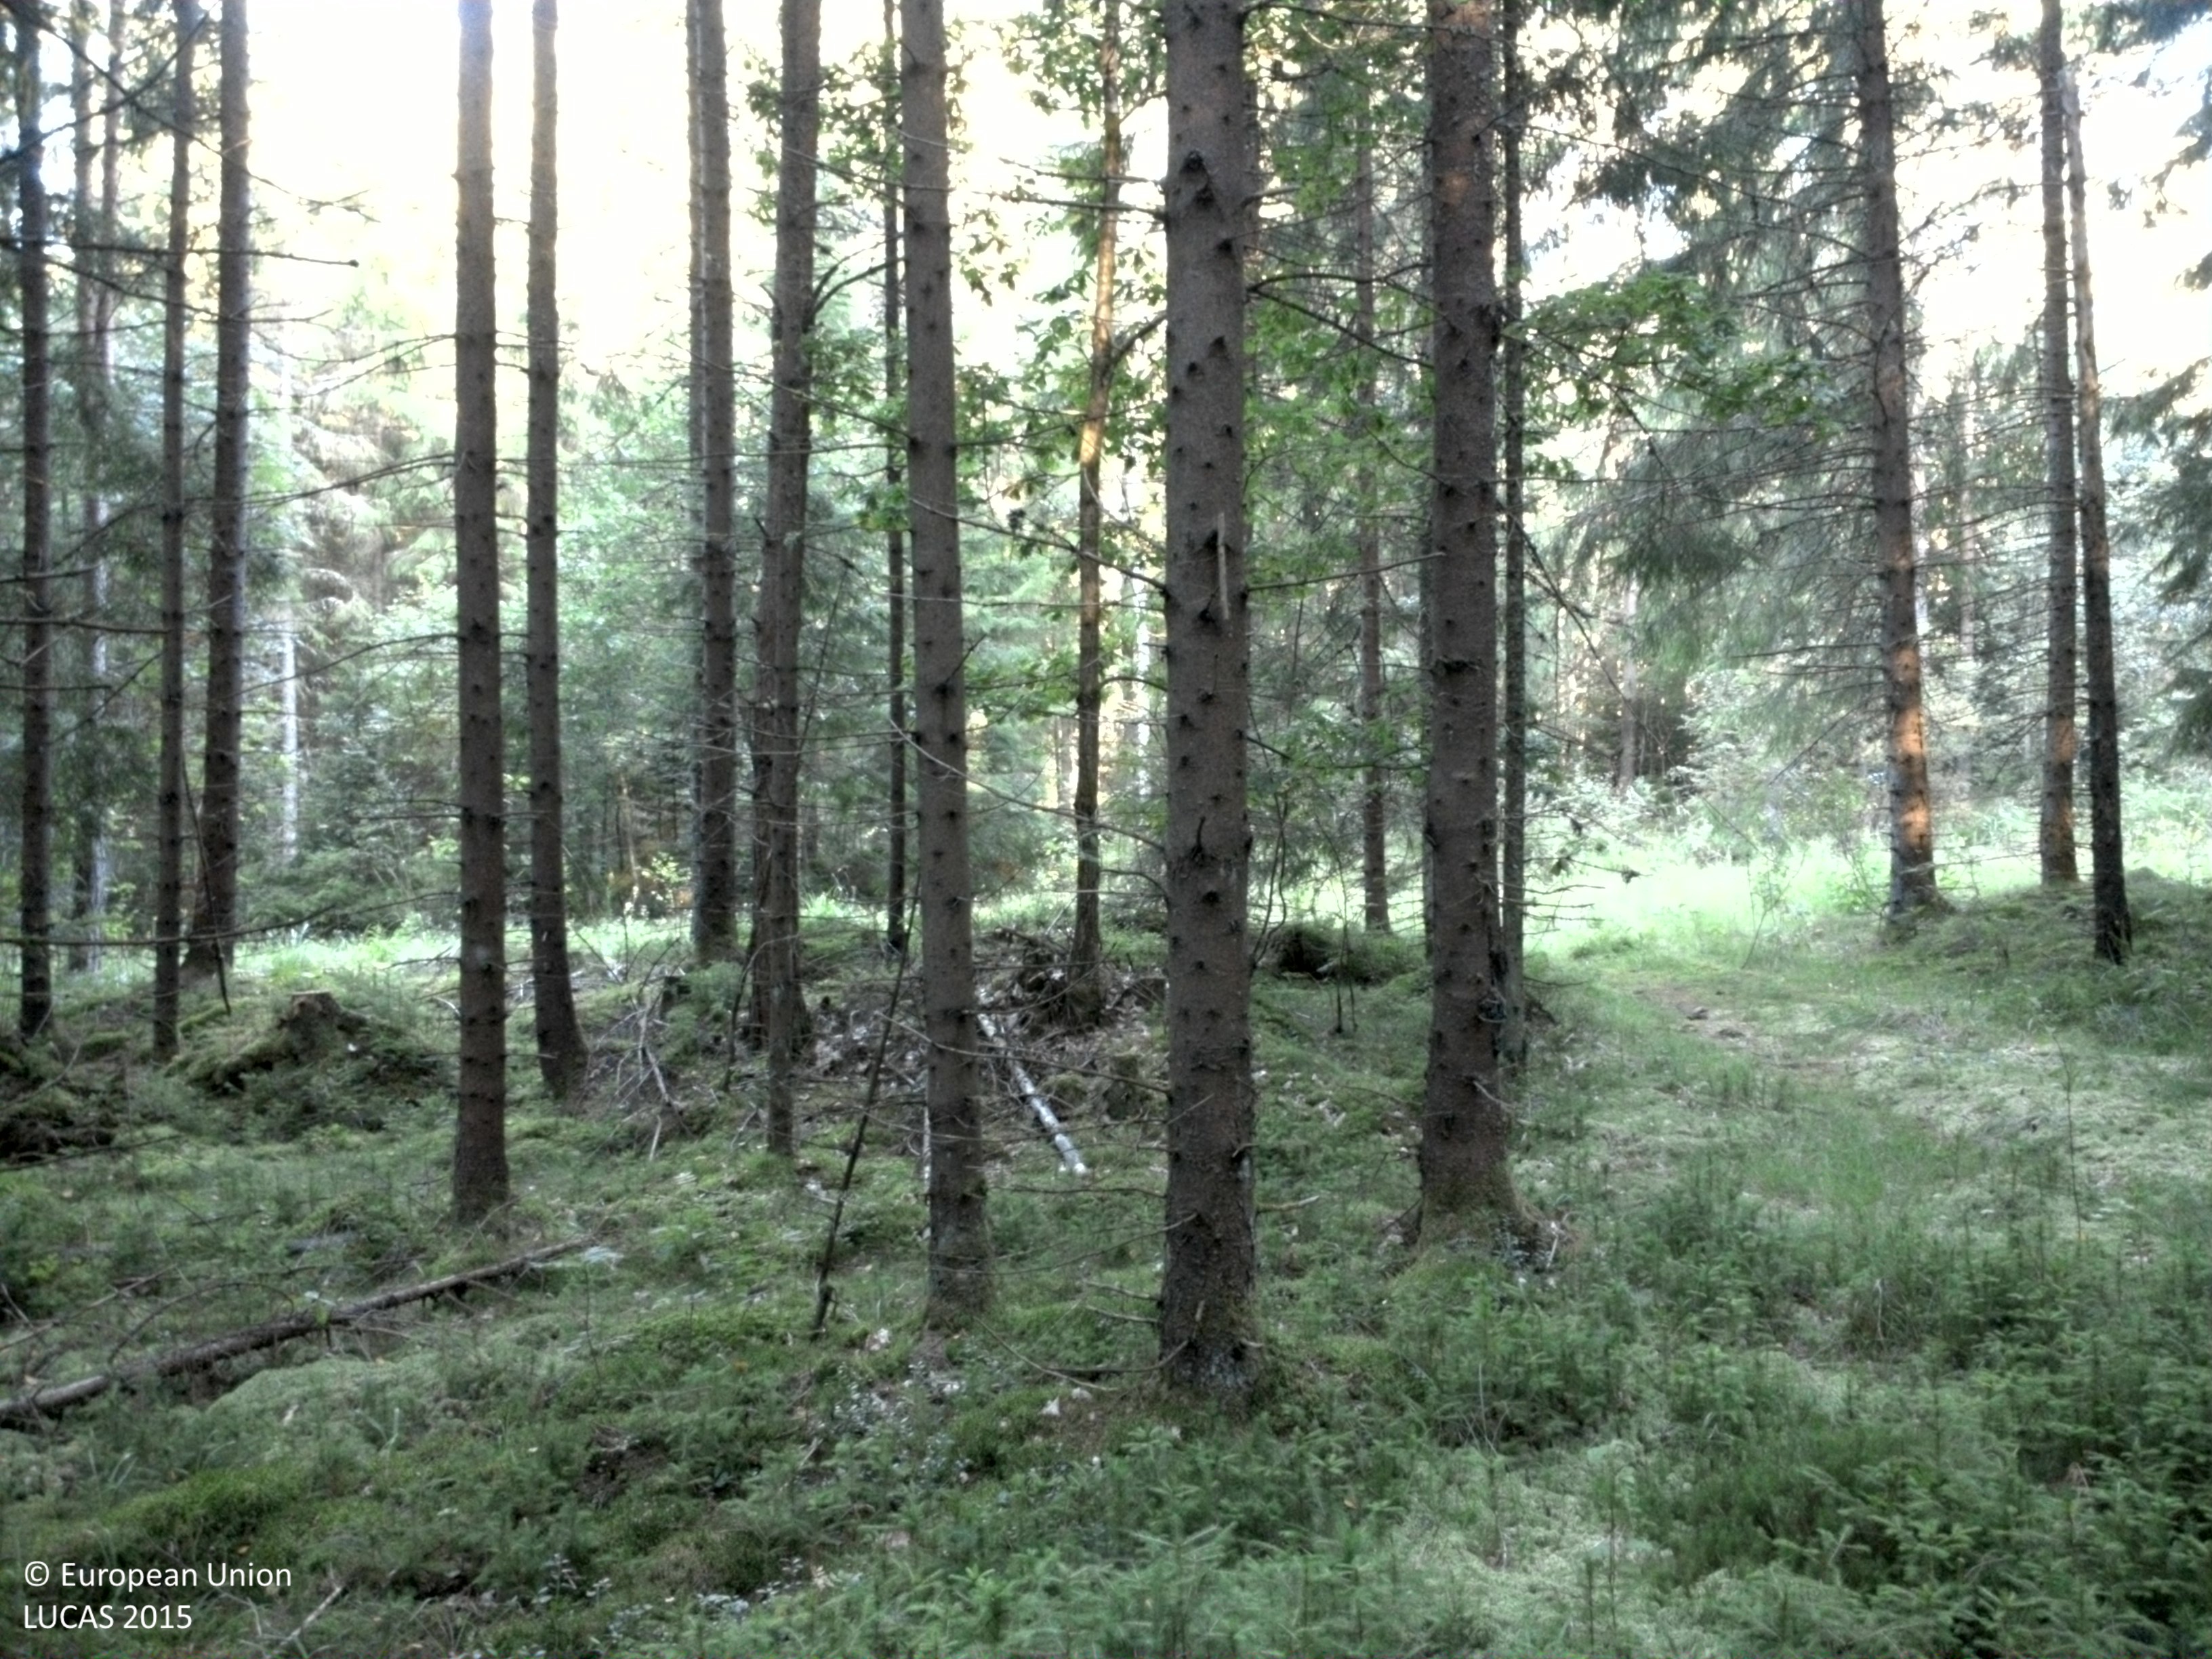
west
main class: Woodland
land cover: Spruce dominated coniferous woodland
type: boreal forest
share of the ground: 50 - 75 %
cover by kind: coniferous forest trees 75 %, lichens and mosses 20 %, shrubs 5 %
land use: Forestry
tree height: > 5 m
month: August
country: SE
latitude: 59.4355
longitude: 13.4653
